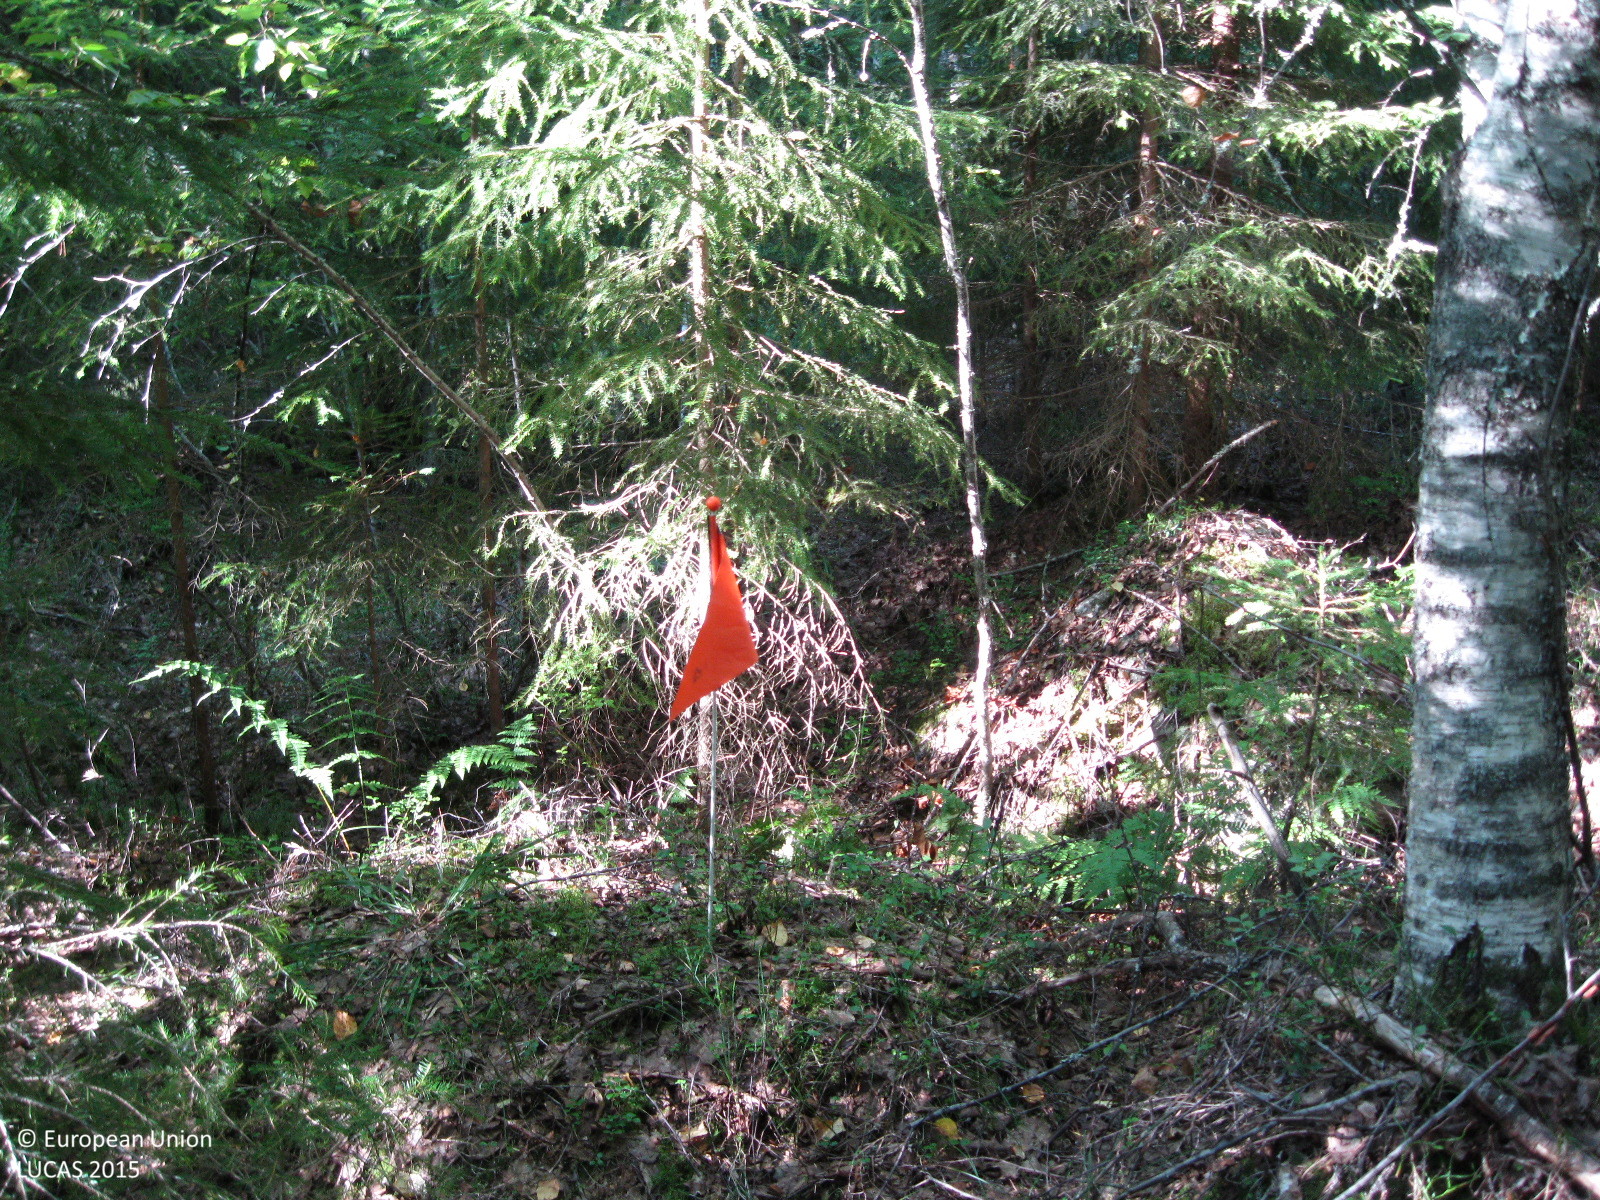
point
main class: Woodland
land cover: Spruce dominated mixed woodland
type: boreal forest
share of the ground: > 75 %
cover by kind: broadleaved forest trees 60 %, coniferous forest trees 30 %, herbaceous plants 10 %
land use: Forestry
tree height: > 5 m
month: August
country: FI
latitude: 61.2219
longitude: 25.0657
